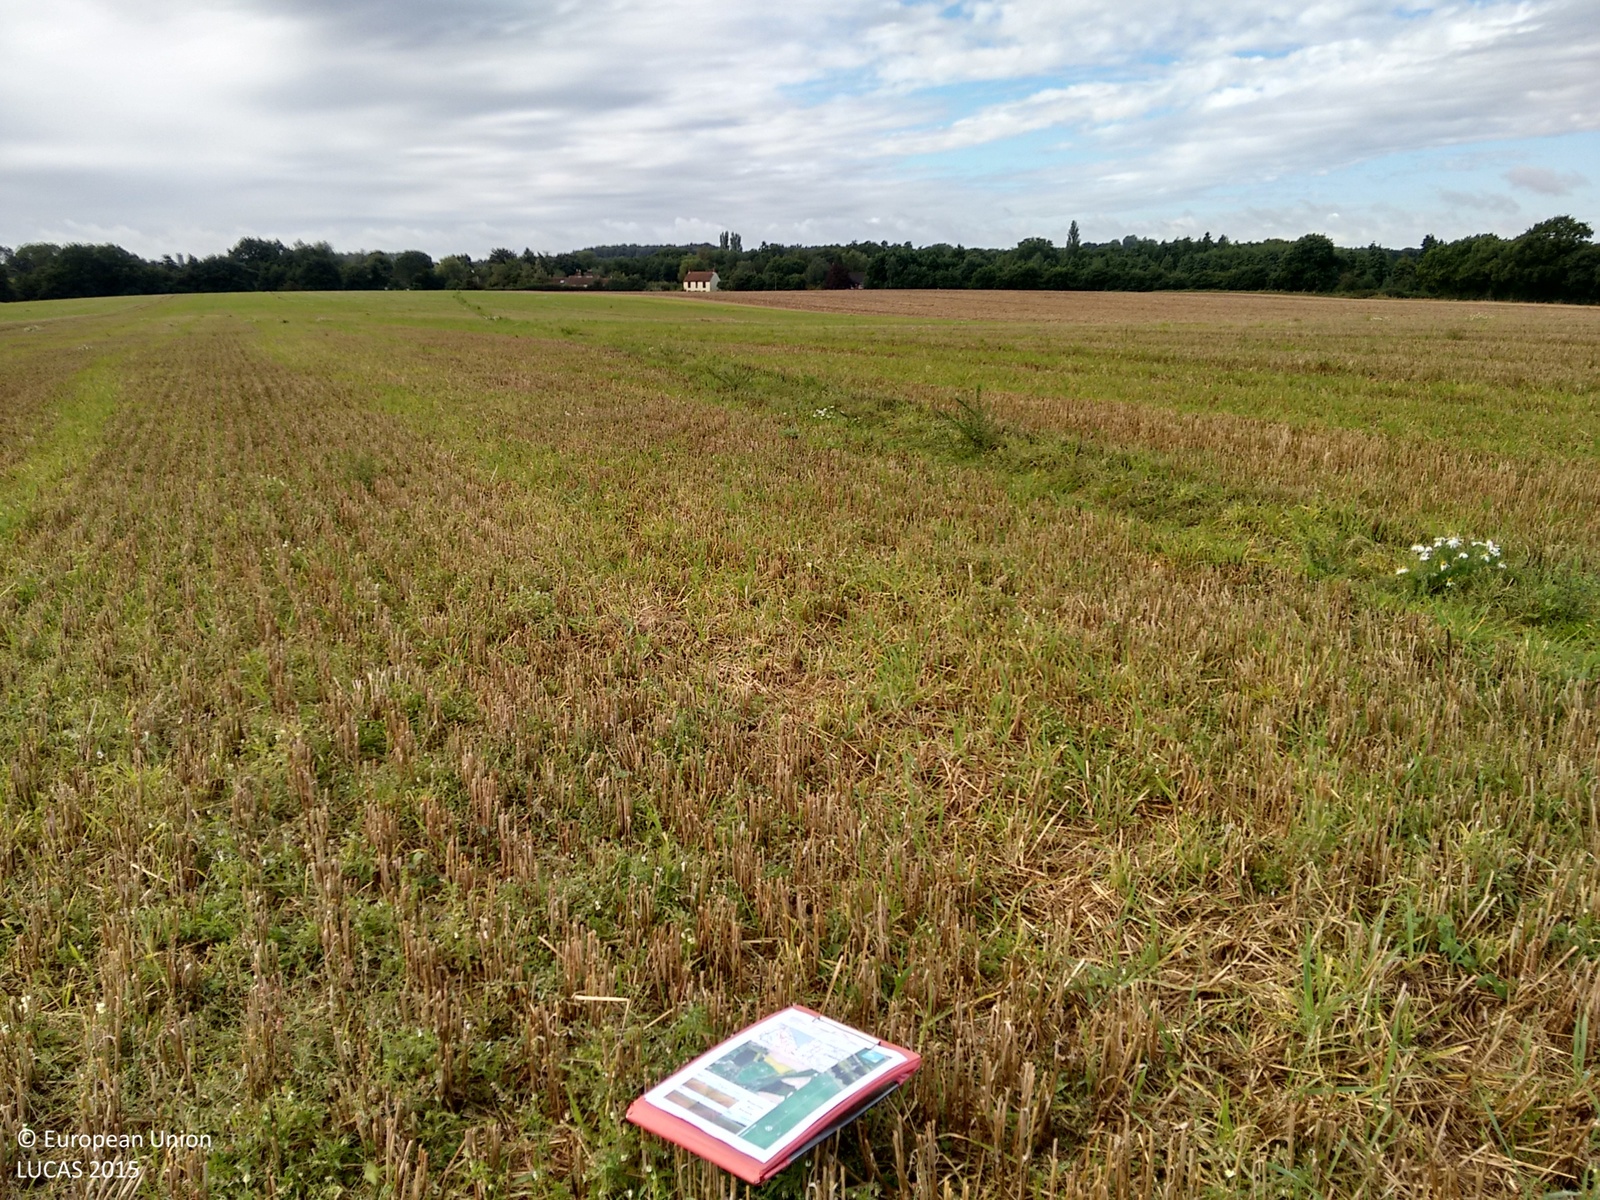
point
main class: Cropland
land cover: Common wheat
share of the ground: > 75 %
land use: Agriculture (excluding fallow land and kitchen gardens)
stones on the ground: 10 - 25 %
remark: Harvested field
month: September
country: GB
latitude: 52.8078
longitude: 1.4209
